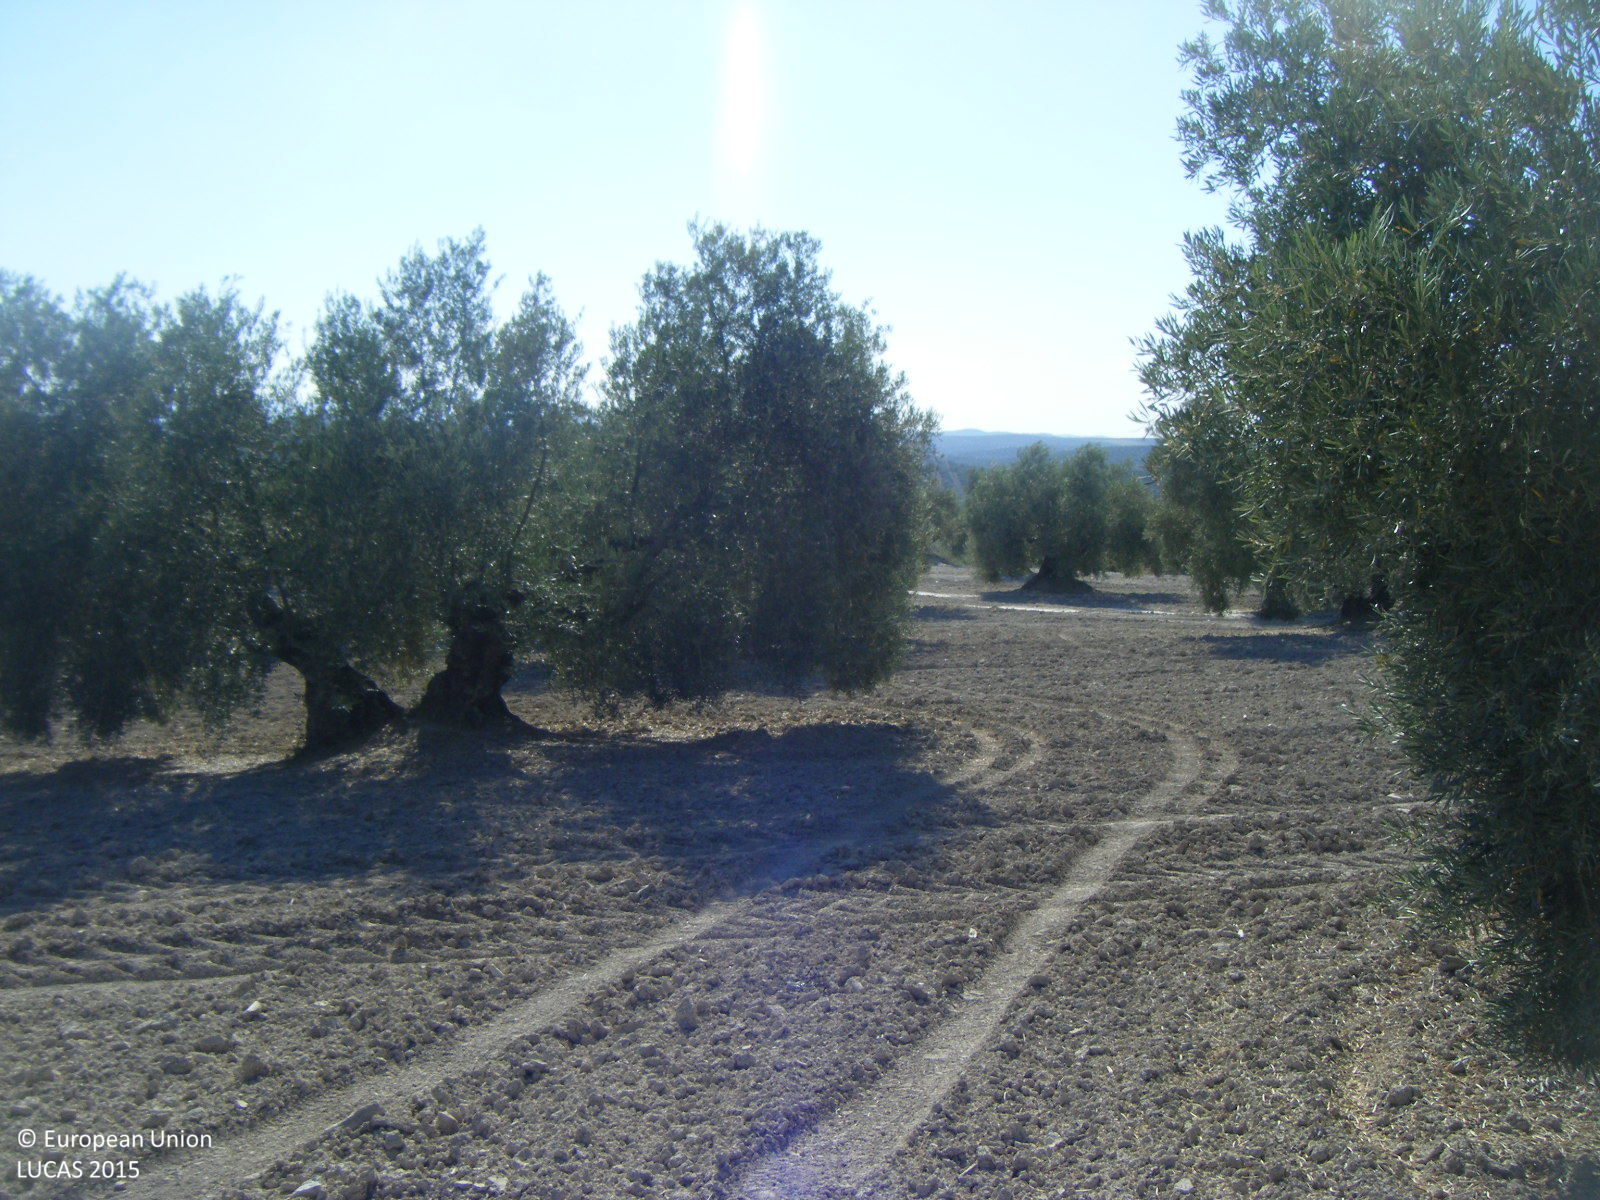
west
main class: Cropland
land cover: Olive groves
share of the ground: 10 - 25 %
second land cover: Other bare soil
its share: > 75 %
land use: Agriculture (excluding fallow land and kitchen gardens)
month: June
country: ES
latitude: 37.2890
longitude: -4.5181
